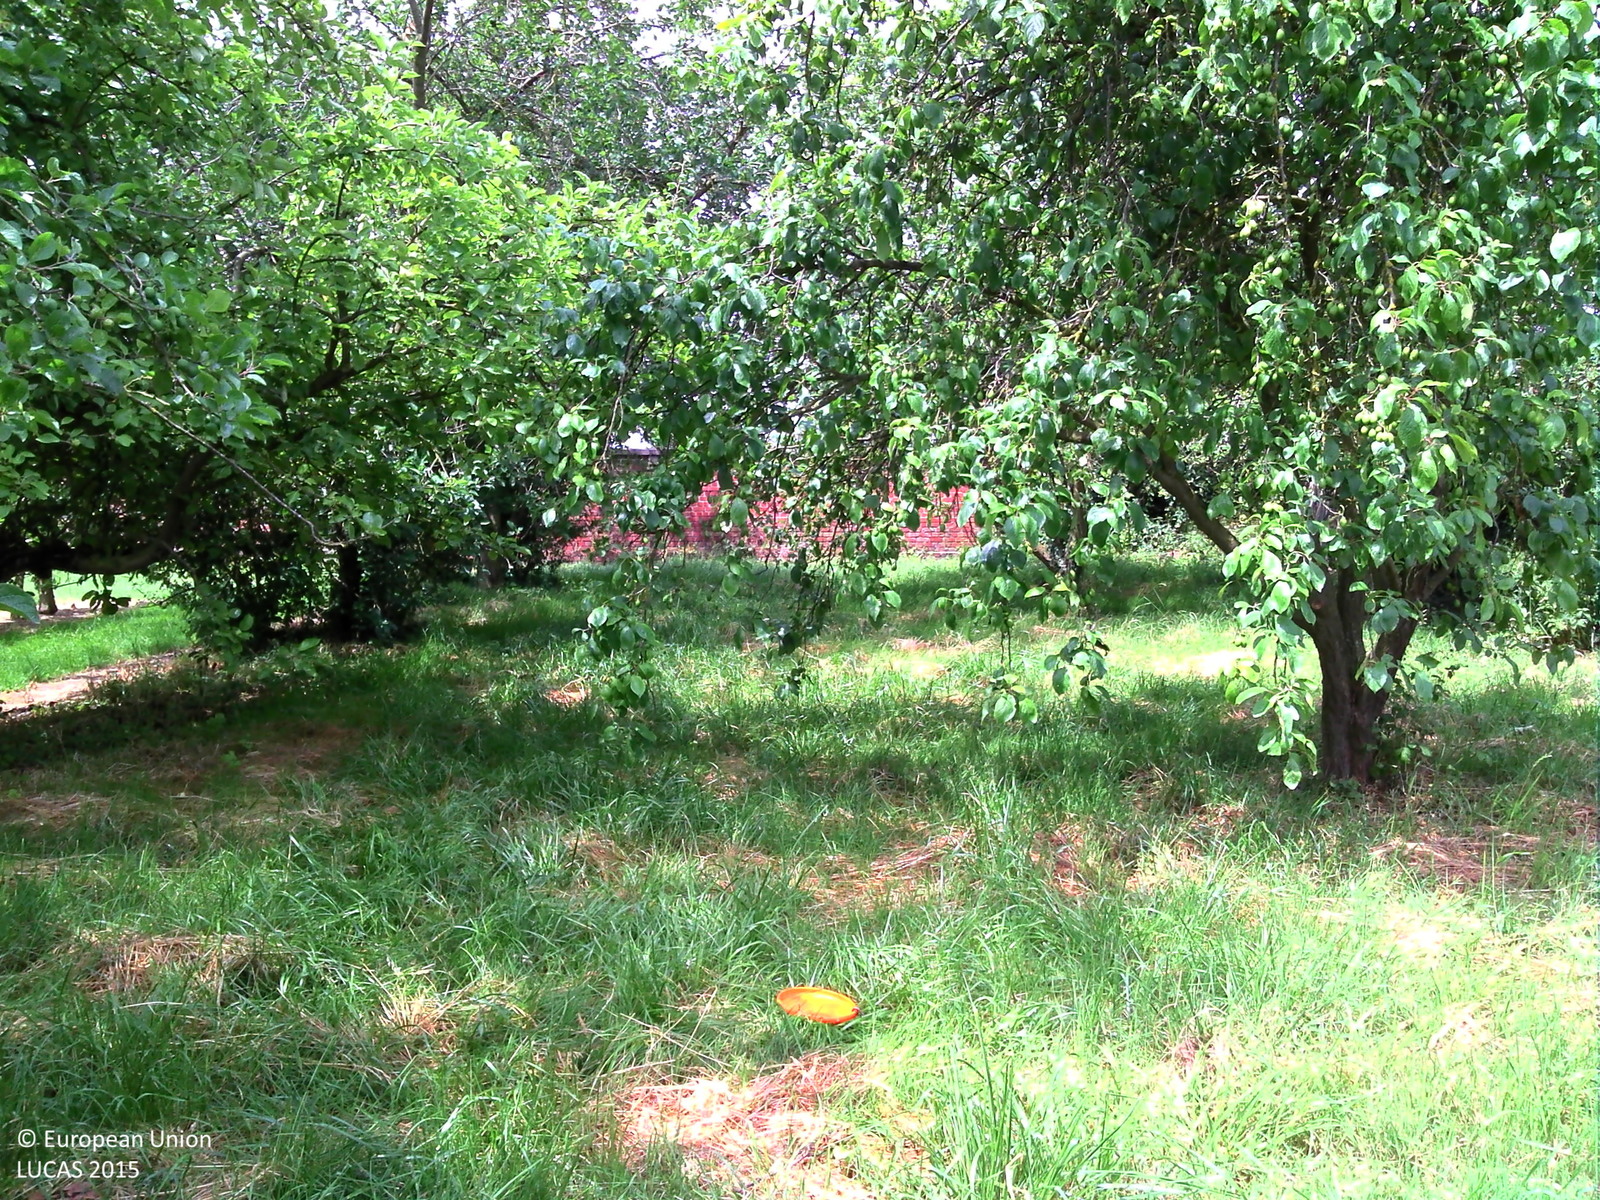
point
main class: Cropland
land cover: Apple fruit
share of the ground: 50 - 75 %
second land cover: Grassland without tree/shrub cover
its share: > 75 %
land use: Agriculture (excluding fallow land and kitchen gardens)
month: June
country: BE
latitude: 50.7261
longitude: 5.5075
